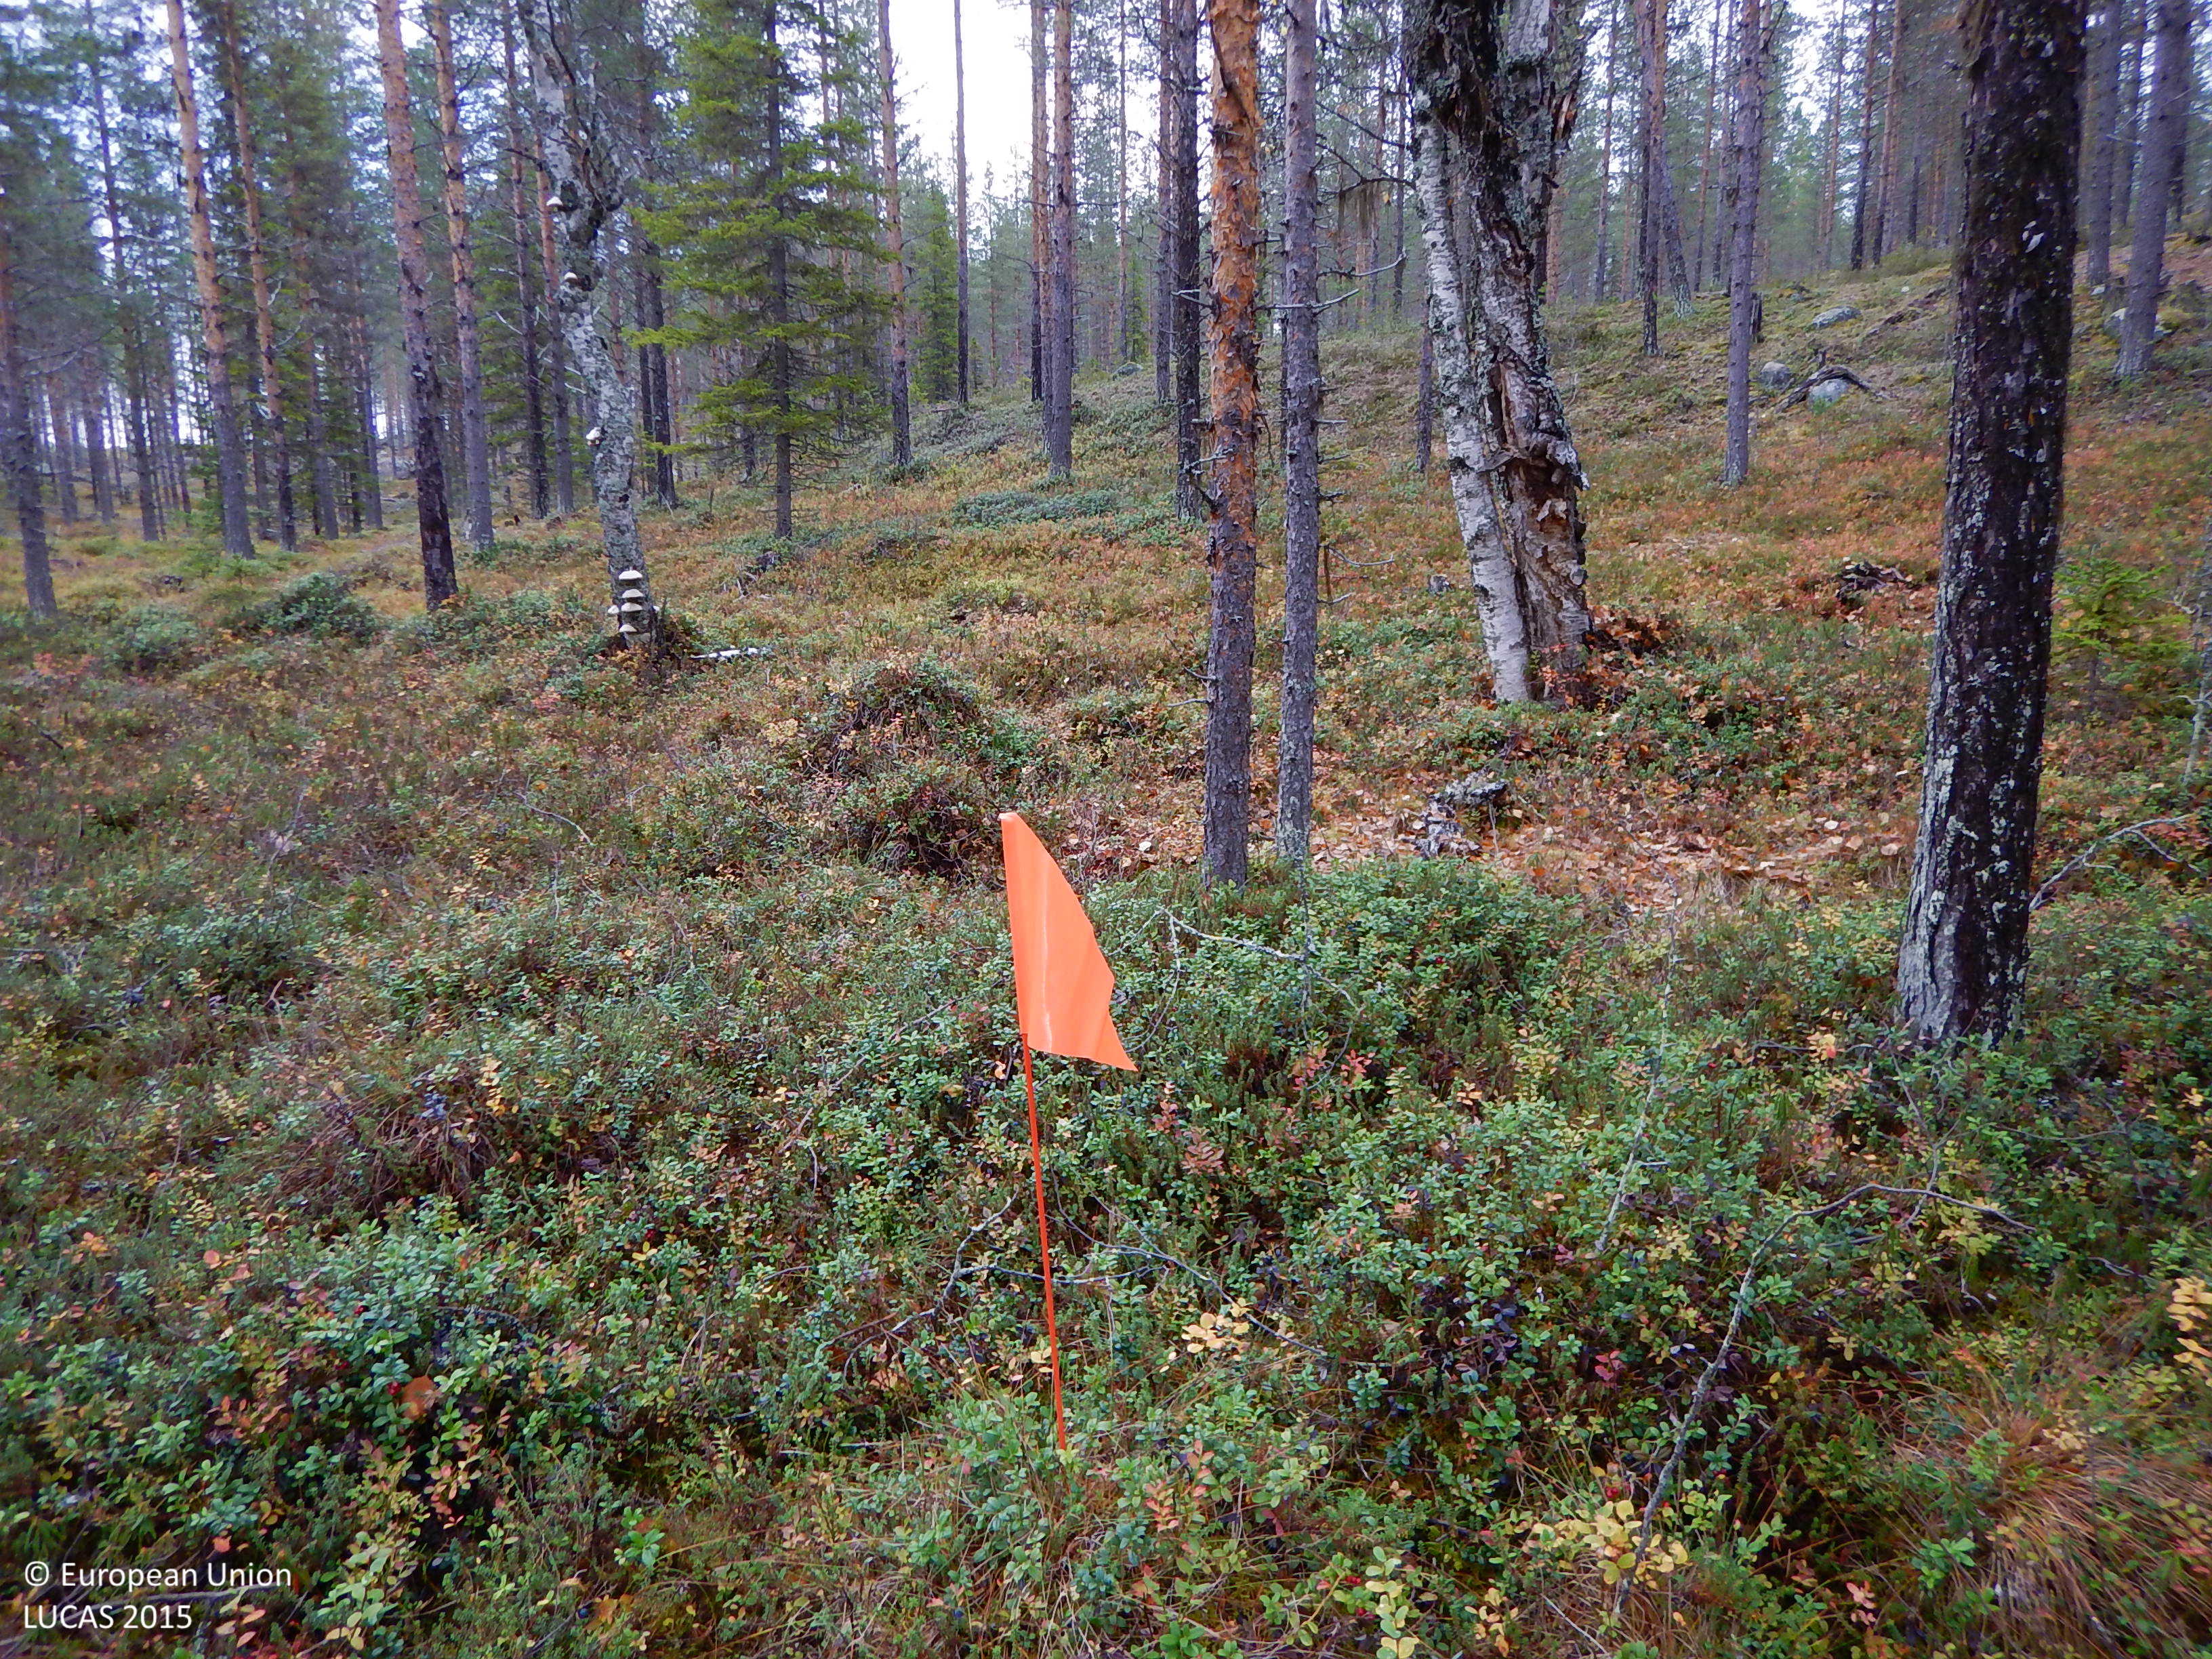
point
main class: Woodland
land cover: Pine dominated coniferous woodland
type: boreal forest
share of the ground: 50 - 75 %
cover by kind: coniferous forest trees 55 %, shrubs 20 %, lichens and mosses 20 %, herbaceous plants 5 %
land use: Forestry
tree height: > 5 m
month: September
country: SE
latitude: 65.0945
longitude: 19.2228
